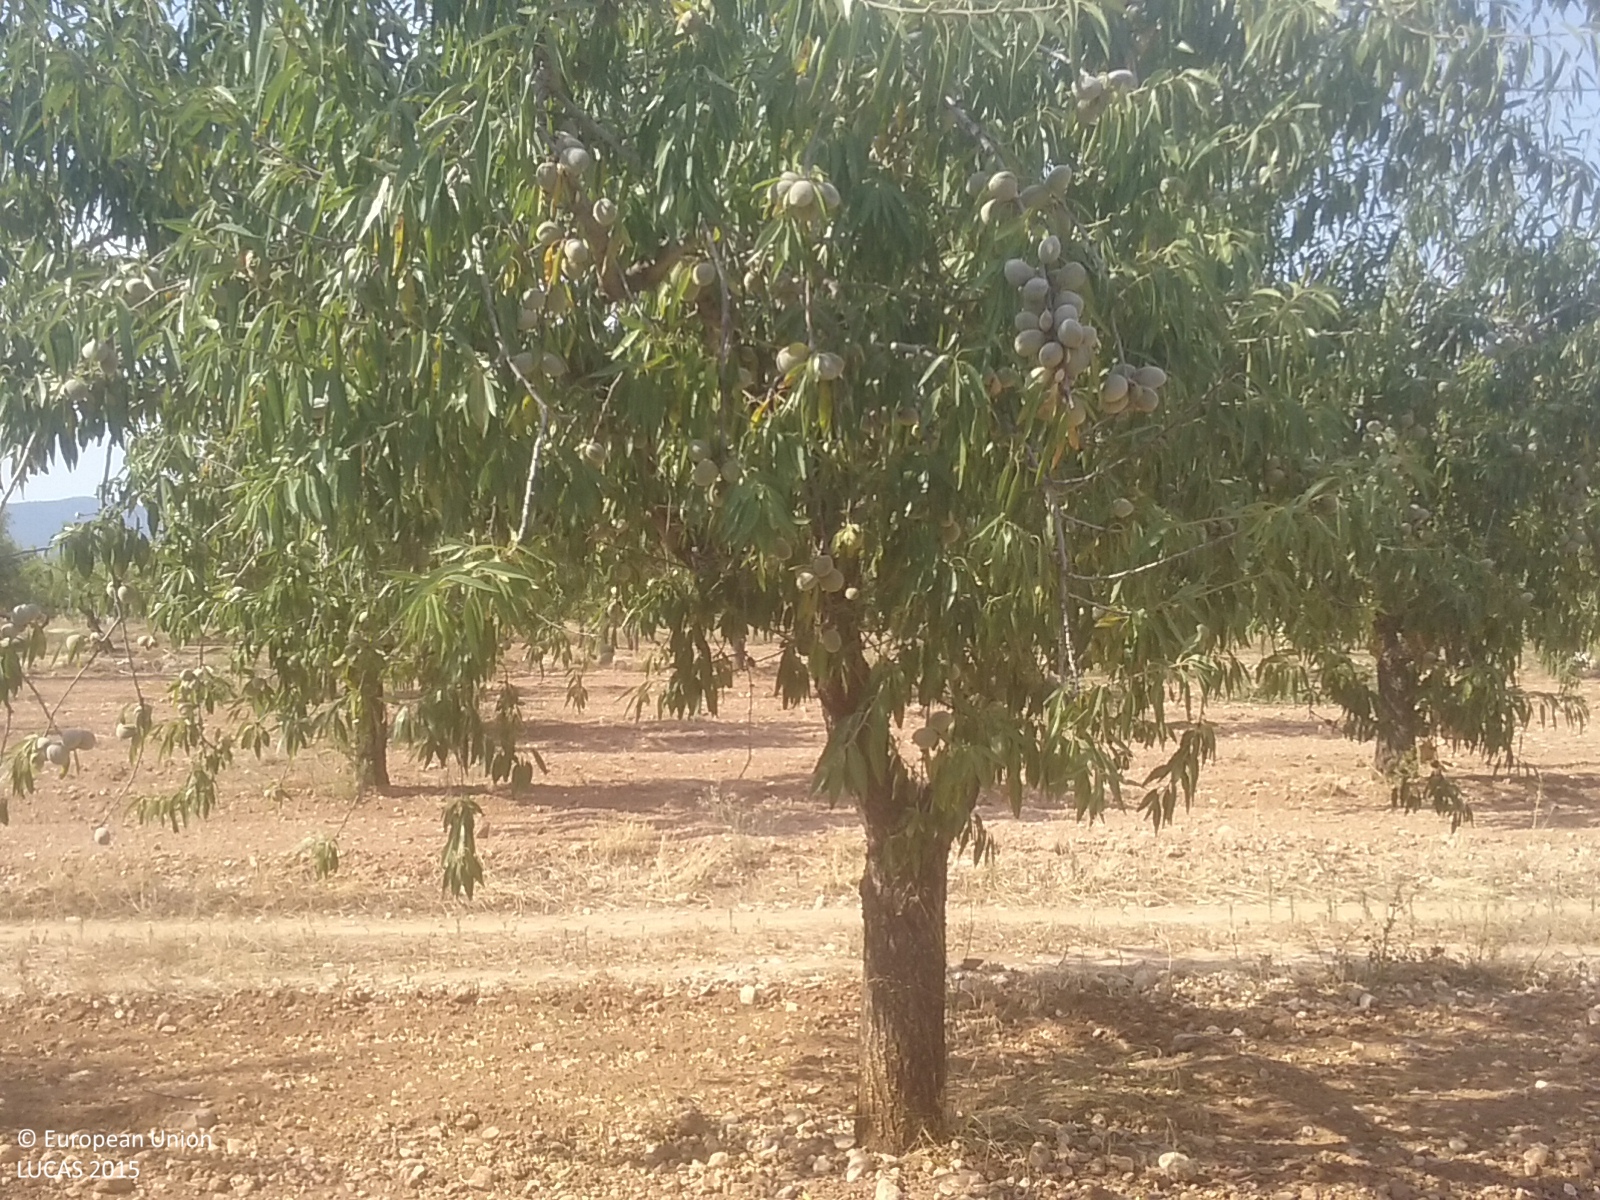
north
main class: Cropland
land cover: Nuts trees
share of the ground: 50 - 75 %
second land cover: Other bare soil
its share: > 75 %
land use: Agriculture (excluding fallow land and kitchen gardens)
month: July
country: ES
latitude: 40.2212
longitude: -0.0743
